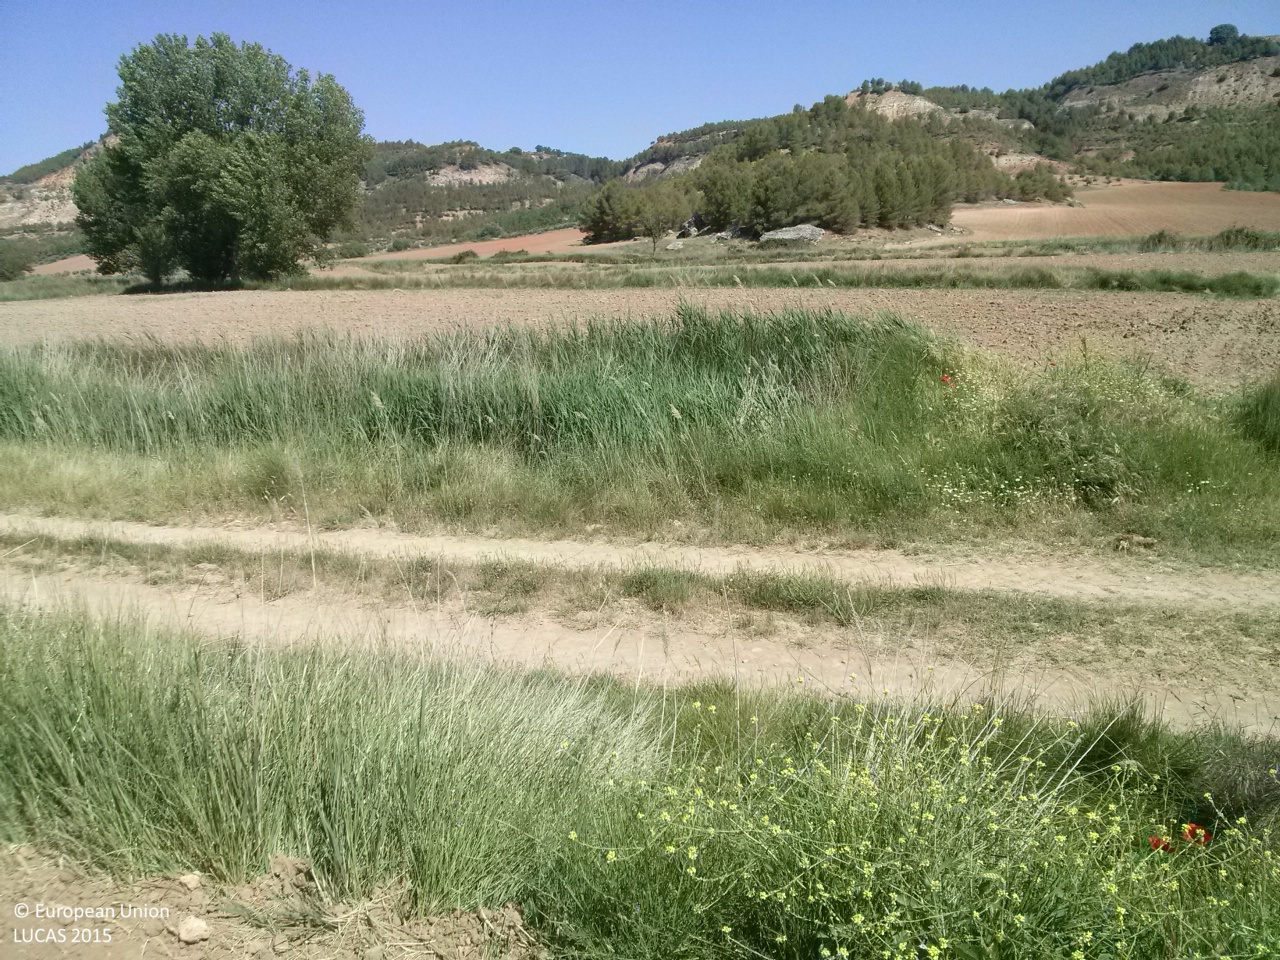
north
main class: Cropland
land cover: Sunflower
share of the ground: < 10 %
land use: Agriculture (excluding fallow land and kitchen gardens)
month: May
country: ES
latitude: 40.1681
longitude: -2.5735
